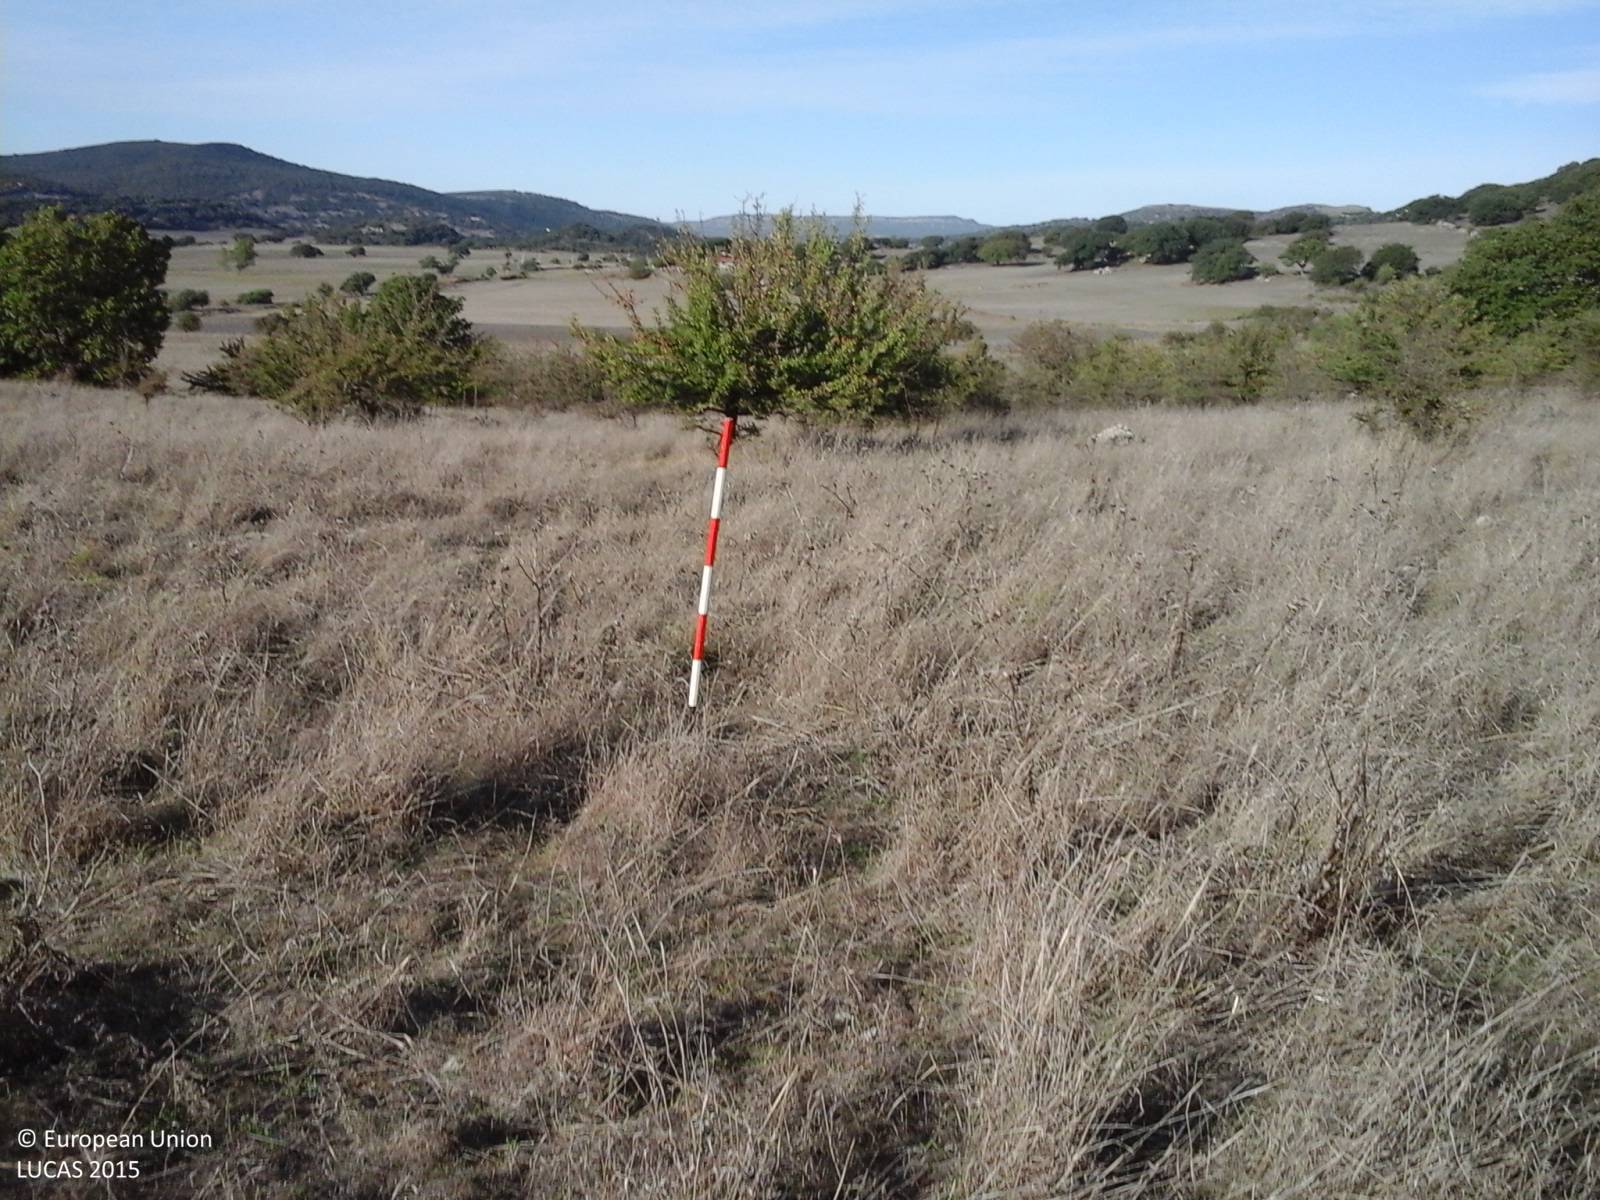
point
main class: Grassland
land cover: Grassland without tree/shrub cover
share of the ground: > 75 %
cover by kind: herbaceous plants 100 %
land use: Agriculture (excluding fallow land and kitchen gardens)
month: October
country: IT
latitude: 40.4019
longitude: 8.5815
